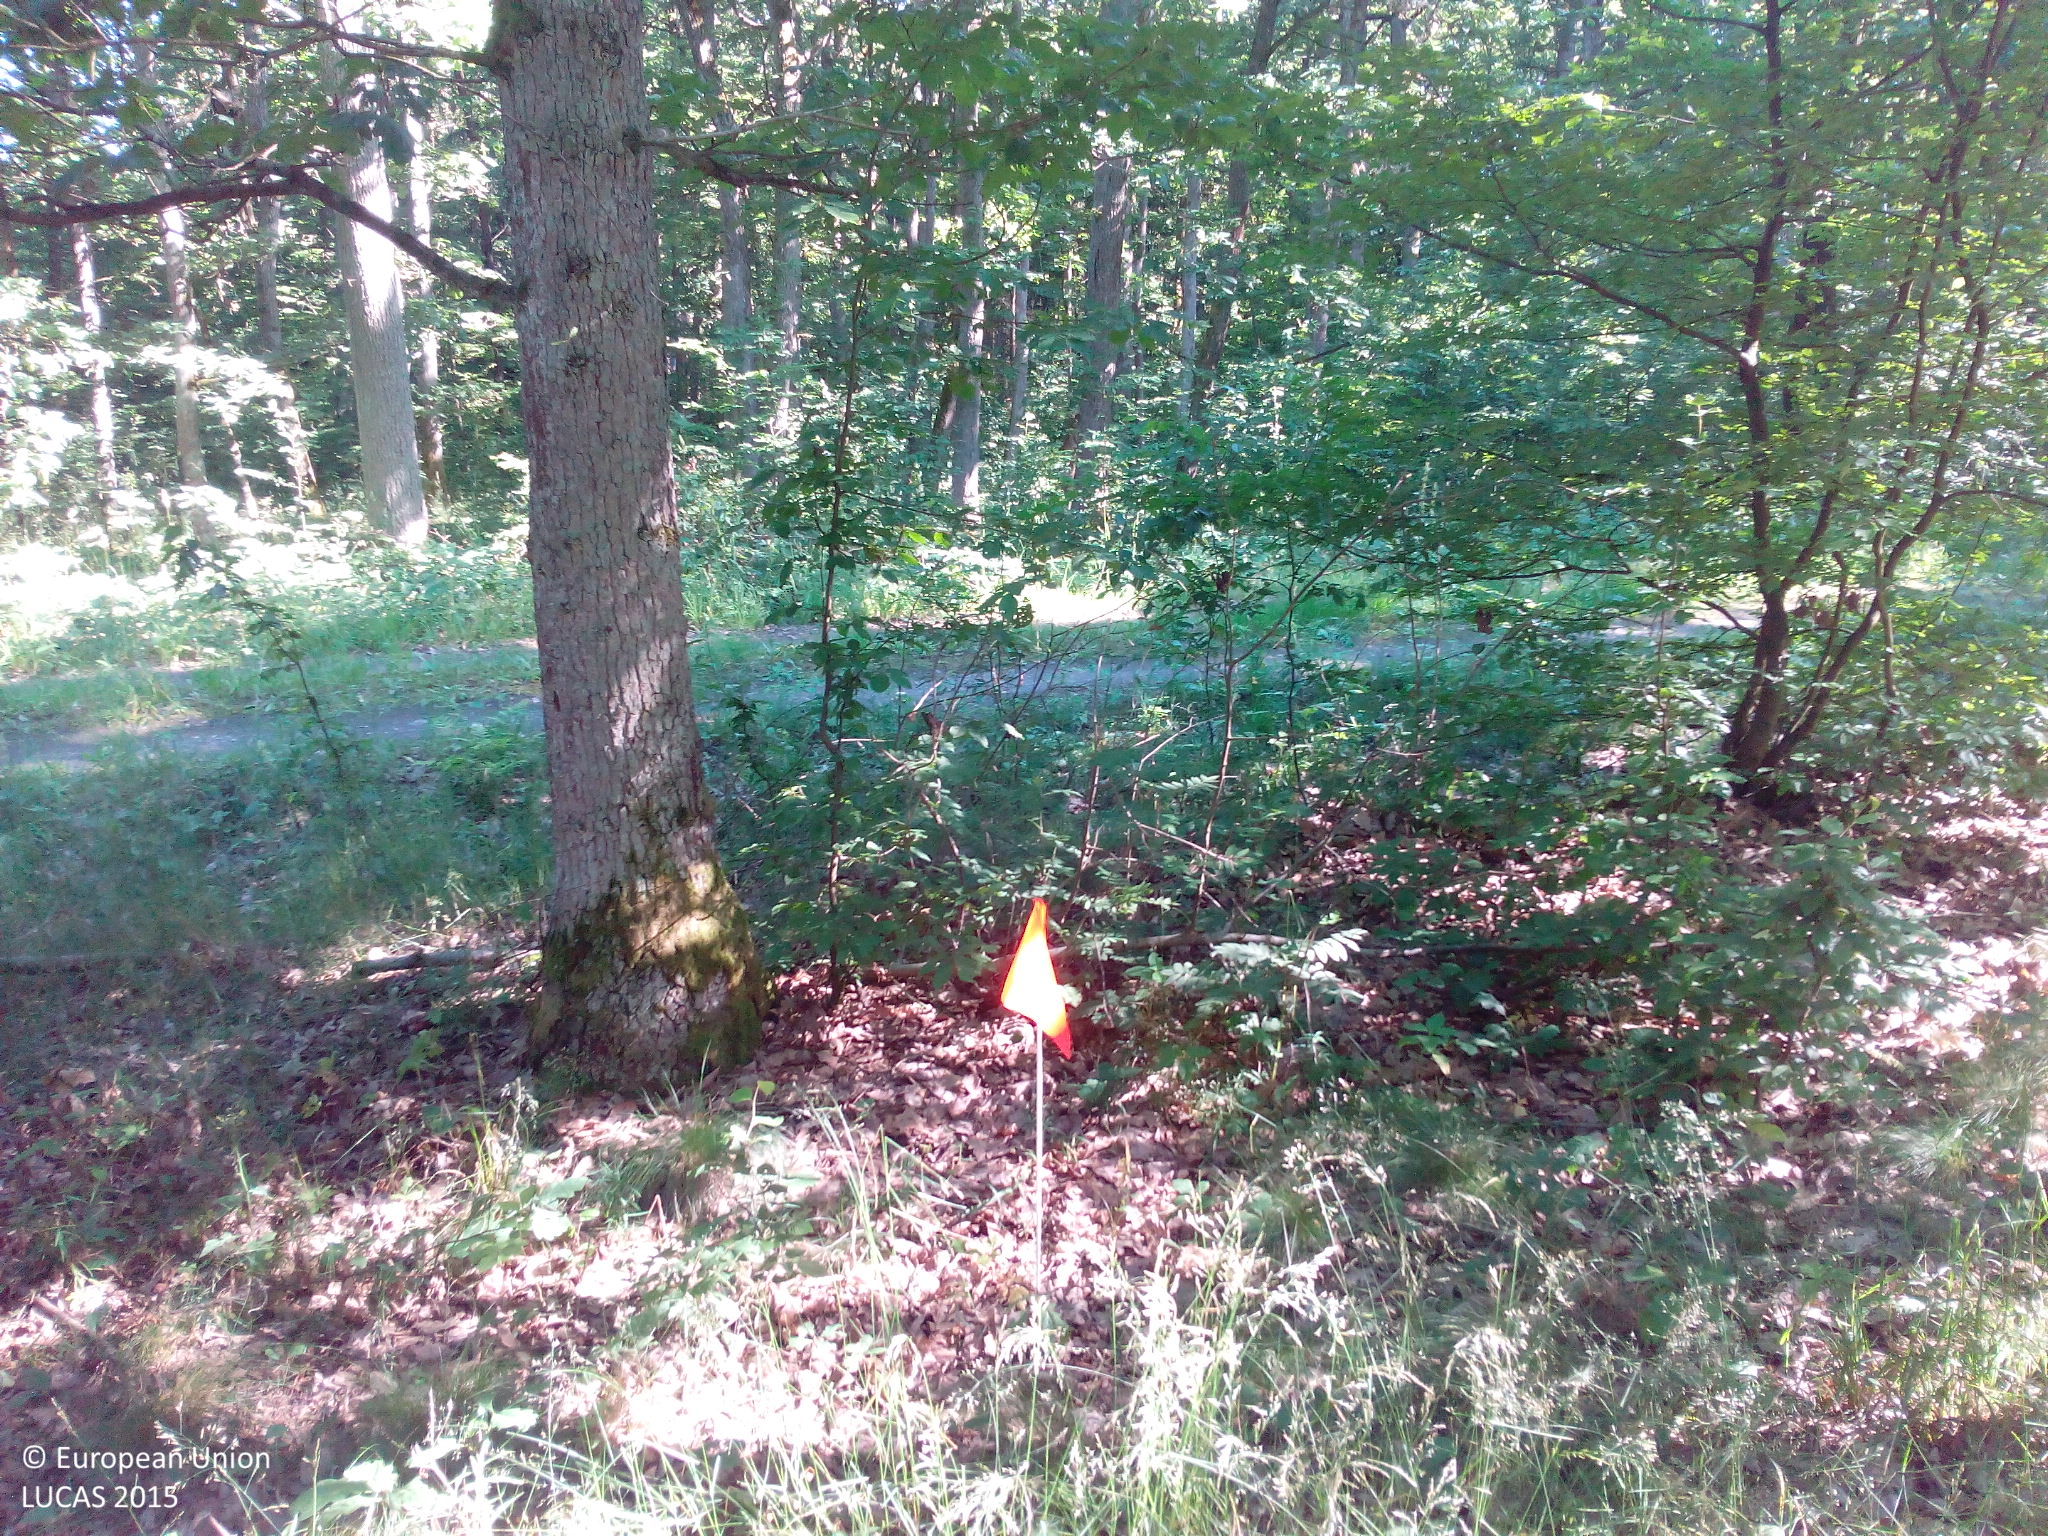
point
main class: Woodland
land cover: Broadleaved woodland
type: mesophytic deciduous forest
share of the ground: > 75 %
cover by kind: broadleaved forest trees 85 %, herbaceous plants 15 %
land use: Forestry
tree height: > 5 m
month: July
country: DE
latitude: 50.3443
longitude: 10.6321
